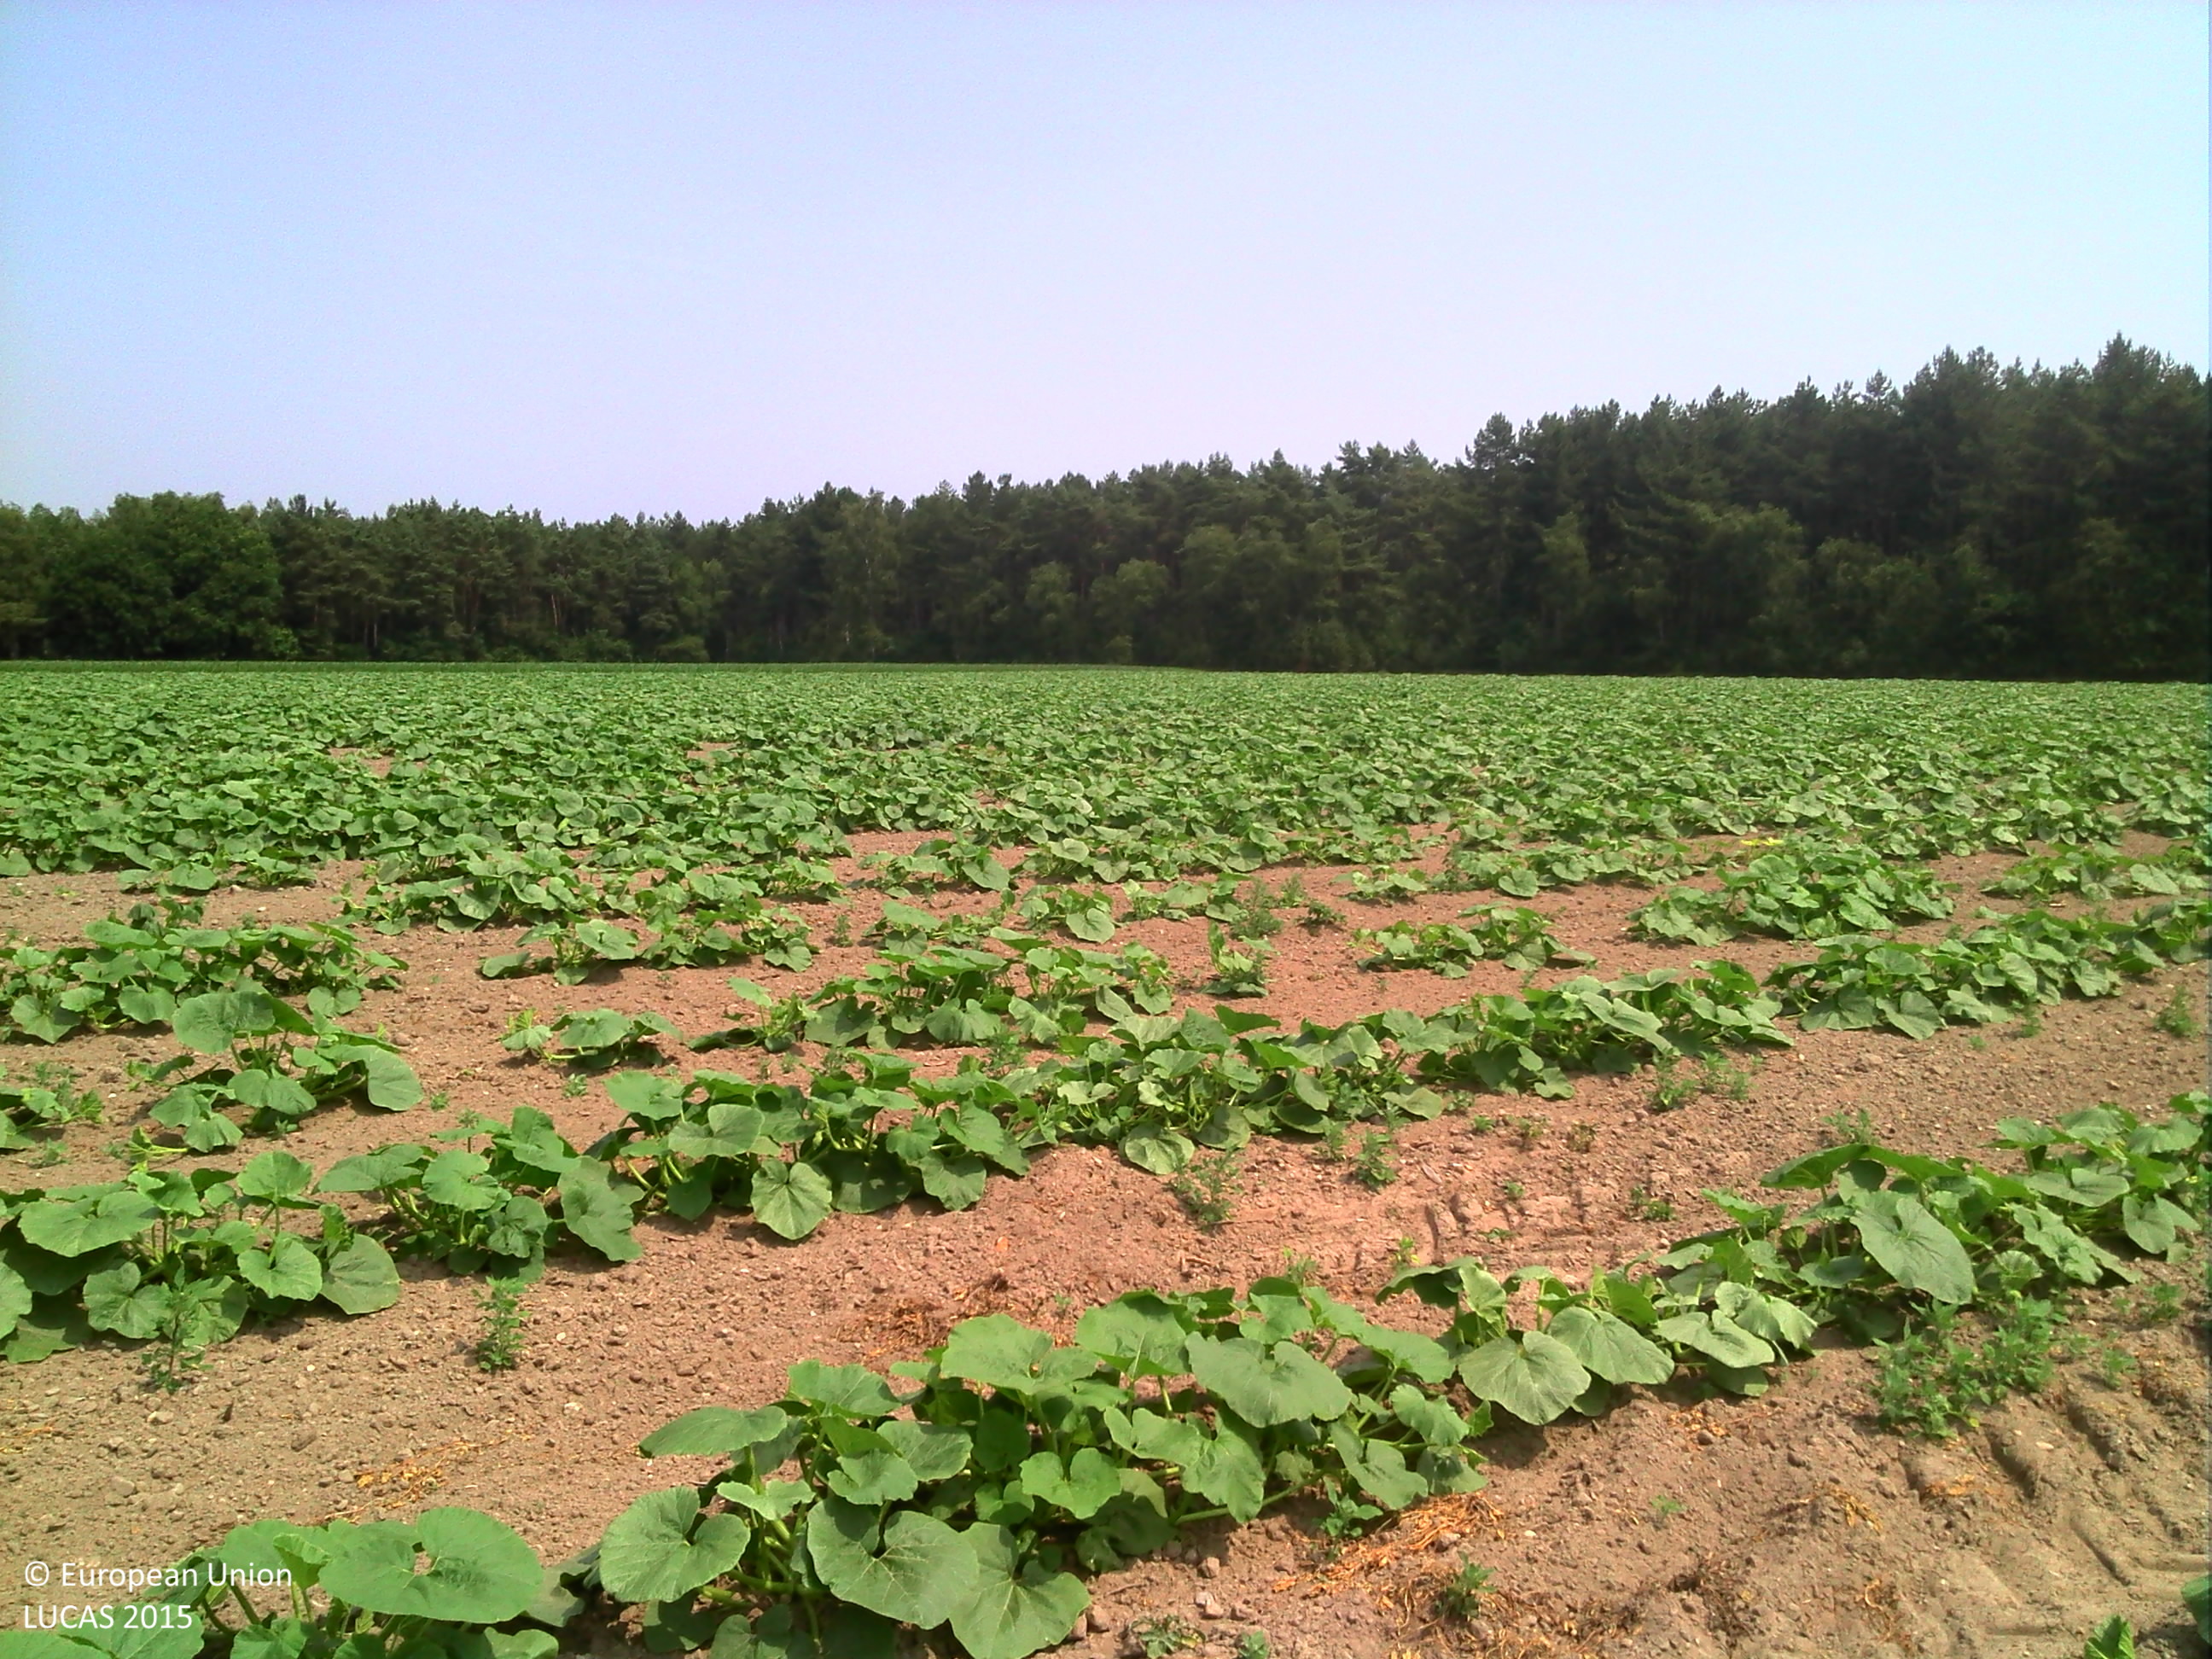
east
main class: Cropland
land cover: Other fresh vegetables
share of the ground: 10 - 25 %
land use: Agriculture (excluding fallow land and kitchen gardens)
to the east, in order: Other fresh vegetables; Maize; Tracks; Pine dominated mixed woodland
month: July
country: BE
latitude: 51.0512
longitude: 5.5331
